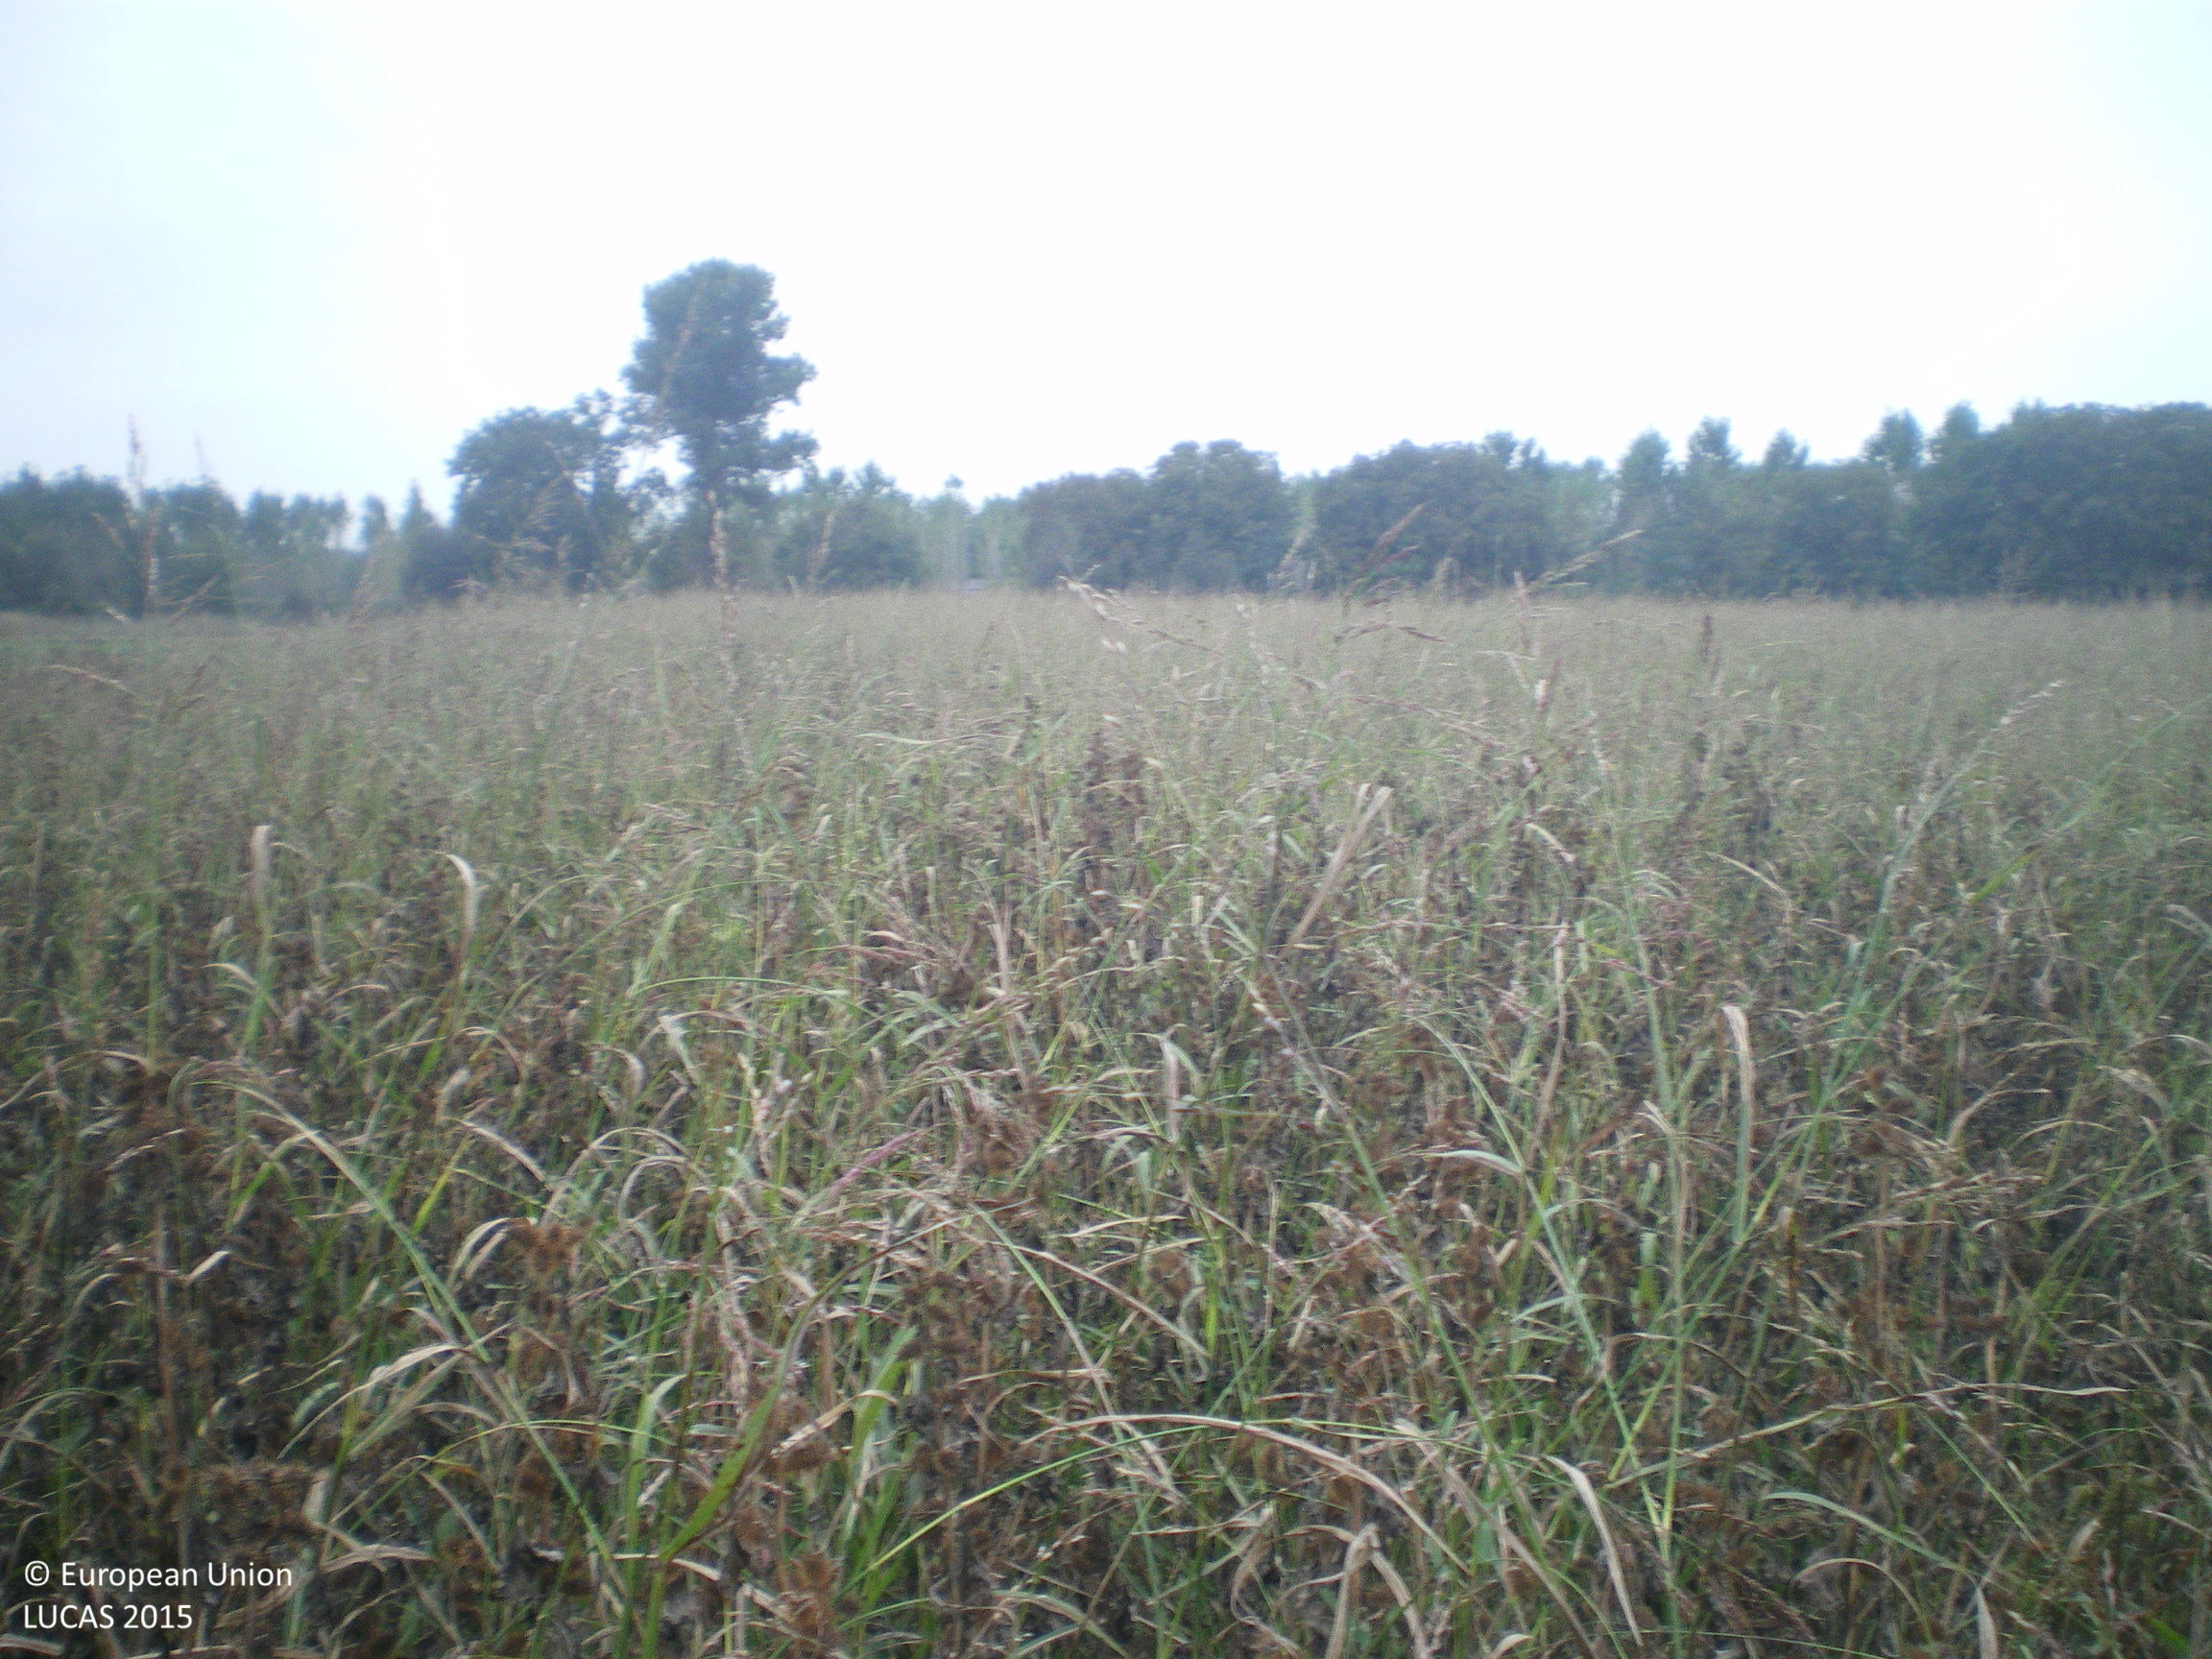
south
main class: Grassland
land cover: Spontaneously vegetated surfaces
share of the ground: > 75 %
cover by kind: herbaceous plants 100 %
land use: Fallow land
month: October
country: BG
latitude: 41.8843
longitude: 26.0167
